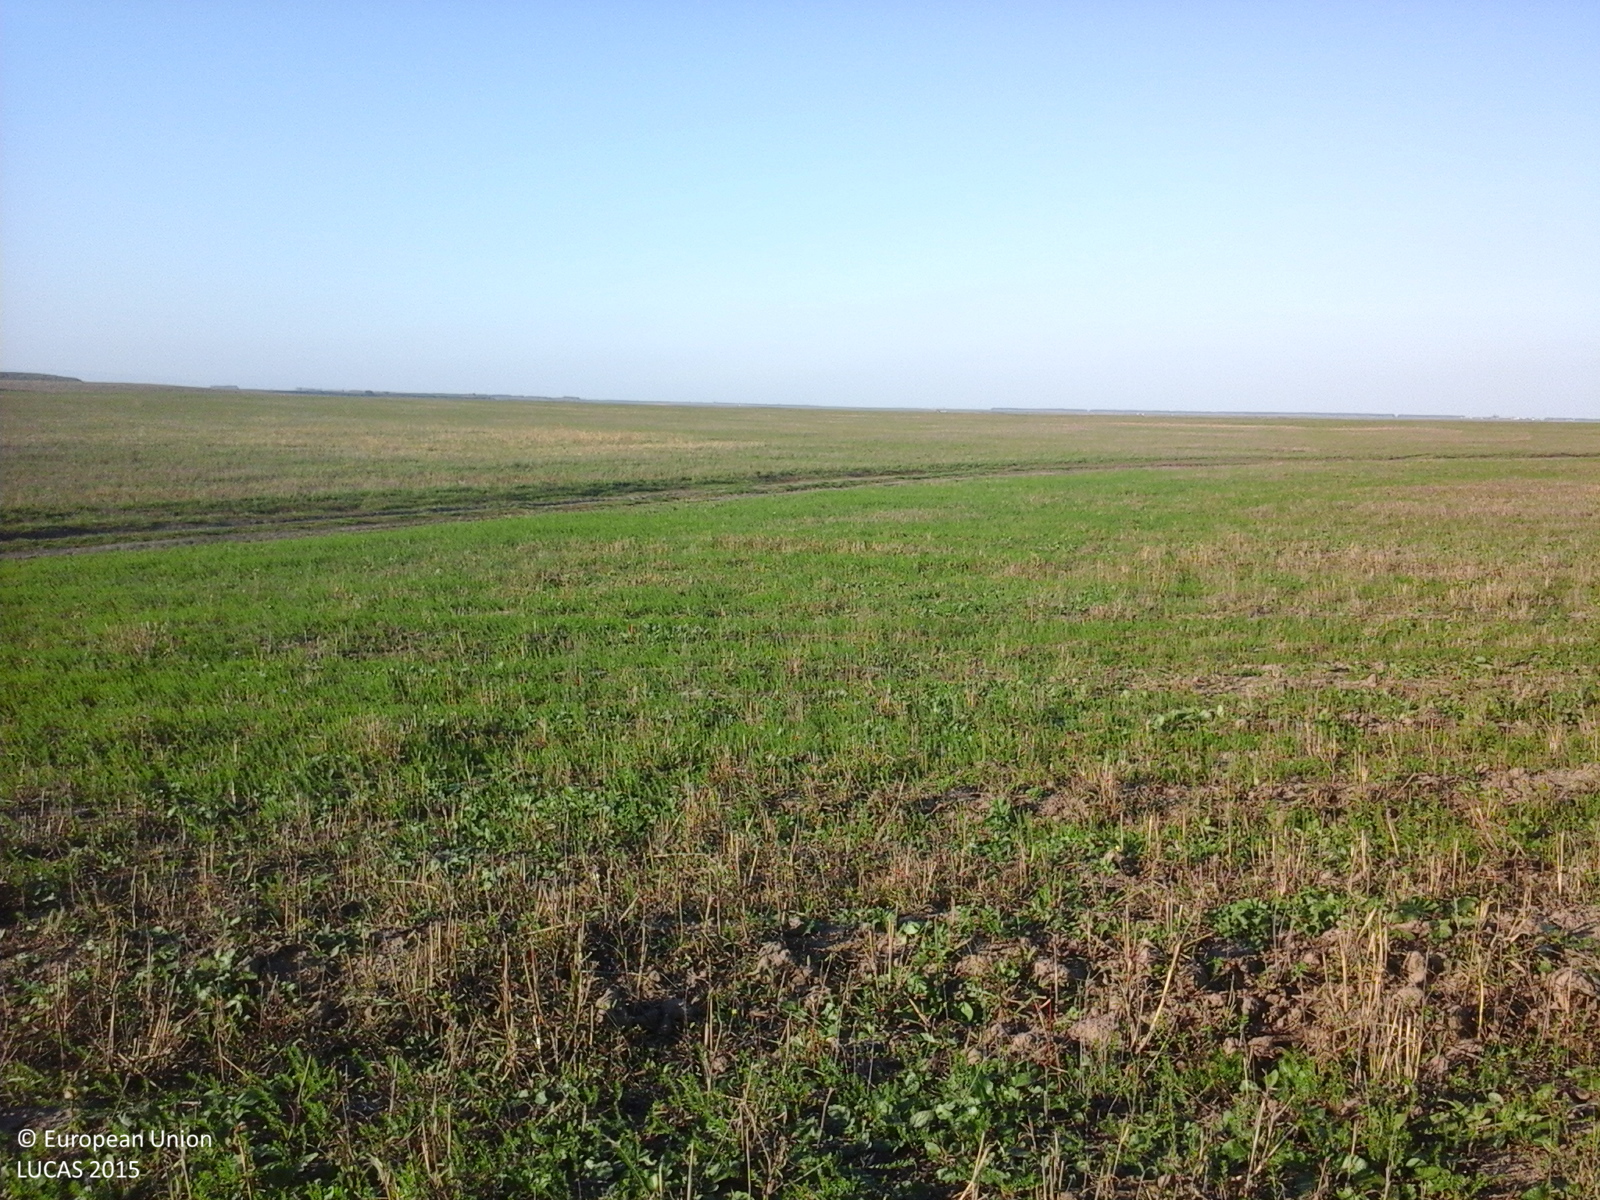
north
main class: Cropland
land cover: Temporary grasslands
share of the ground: > 75 %
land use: Agriculture (excluding fallow land and kitchen gardens)
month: October
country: RO
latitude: 45.3753
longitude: 27.3746
